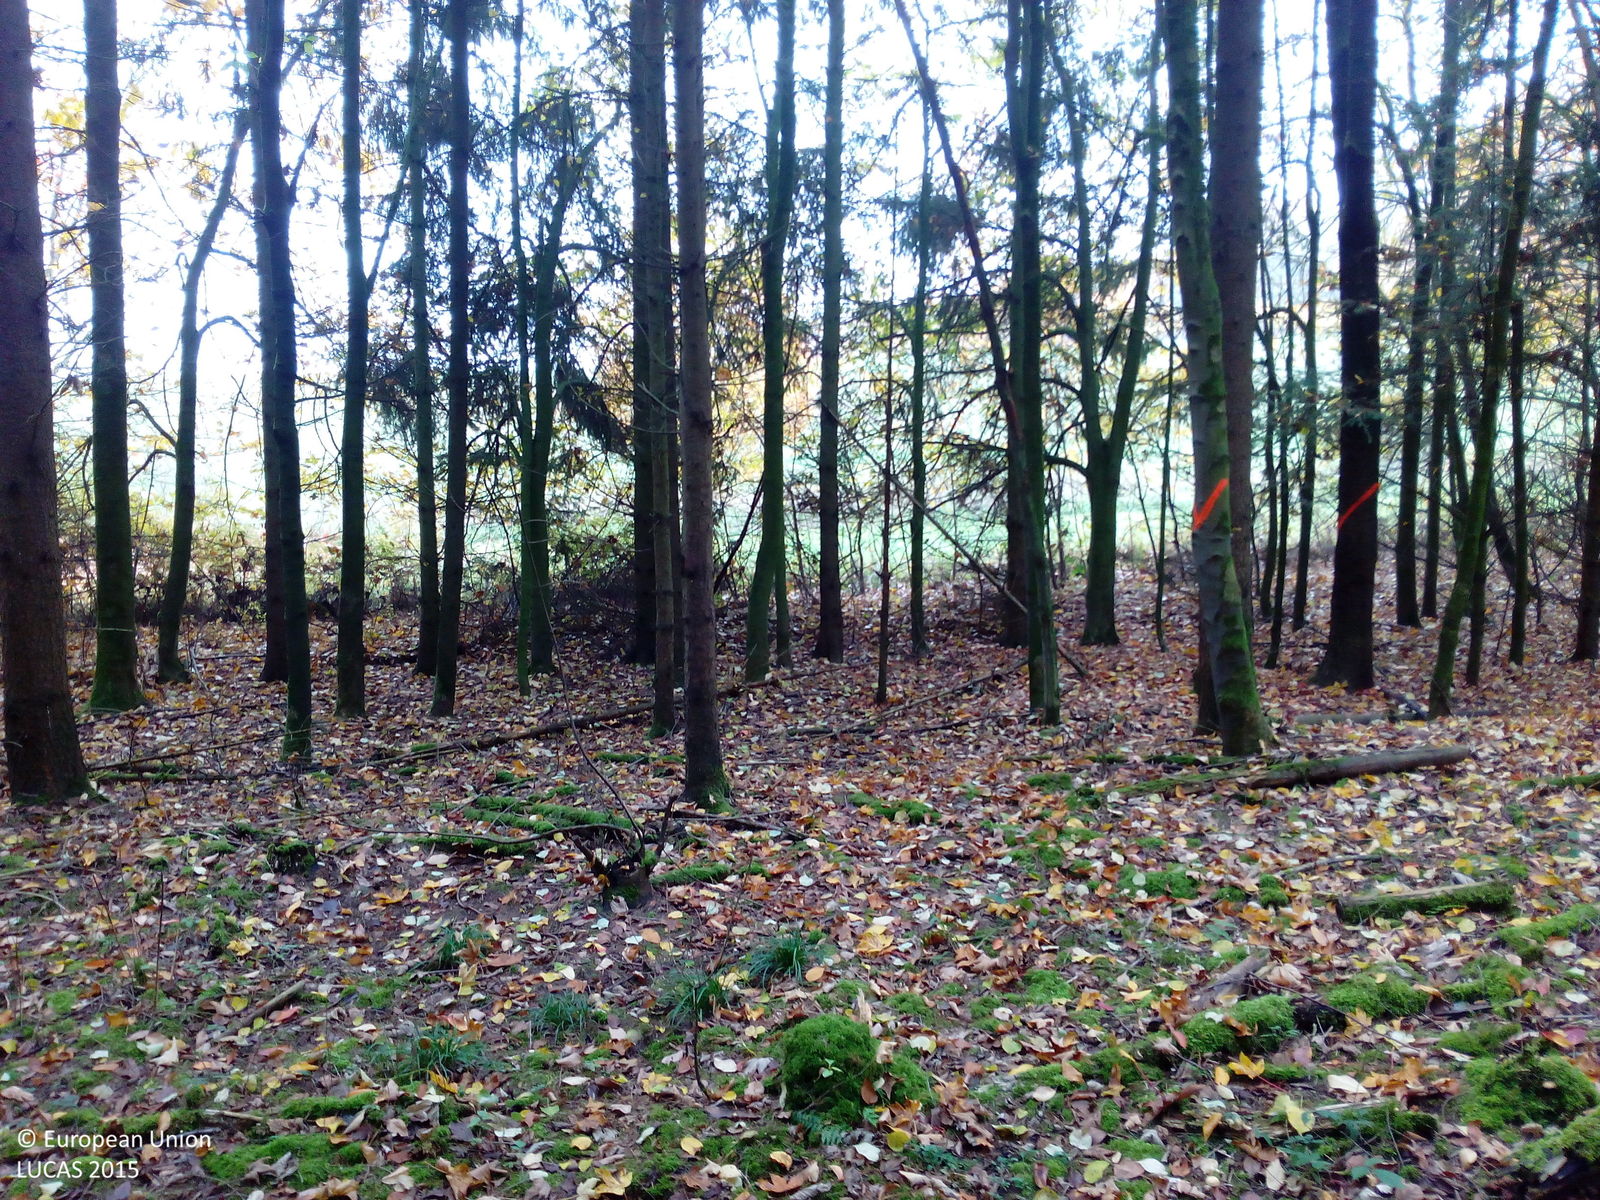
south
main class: Woodland
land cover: Spruce dominated mixed woodland
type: hemiboreal forest and nemoral coniferous forest and mixed broadleaved-coniferous forest
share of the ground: 50 - 75 %
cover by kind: coniferous forest trees 35 %, broadleaved forest trees 25 %, unconsolidated bare surface 20 %, lichens and mosses 15 %, shrubs 5 %
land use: Forestry
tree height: > 5 m
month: October
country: DE
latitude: 50.1662
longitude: 9.9580
